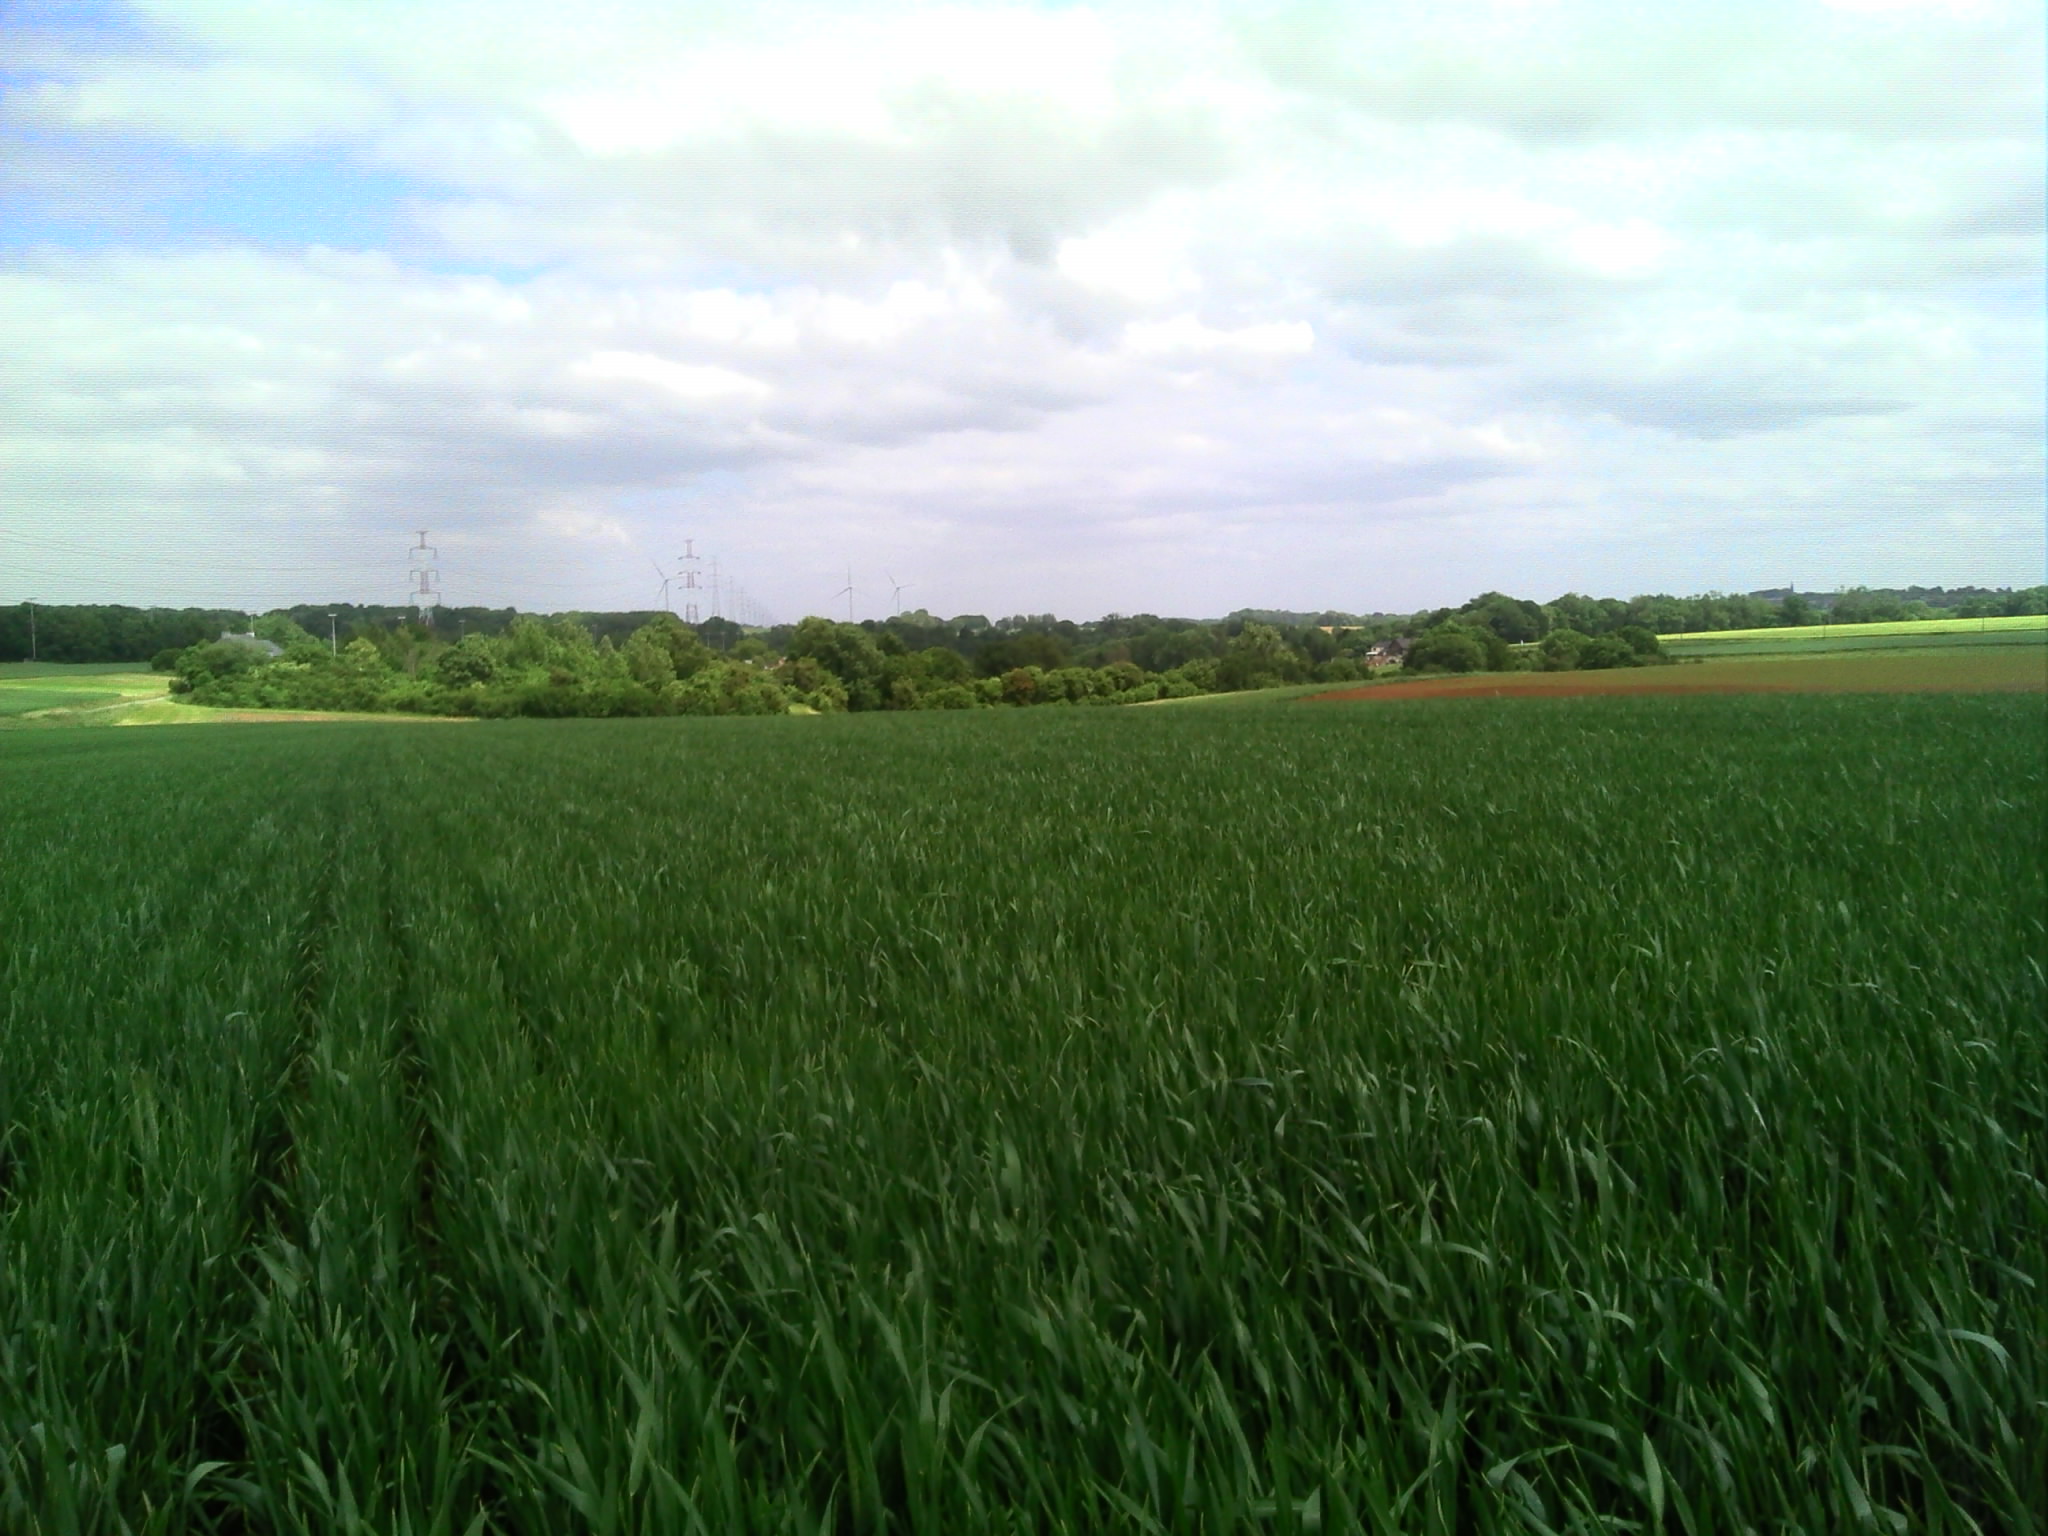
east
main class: Cropland
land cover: Common wheat
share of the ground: > 75 %
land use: Agriculture (excluding fallow land and kitchen gardens)
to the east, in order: Common wheat; Potatoes
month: June
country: BE
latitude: 50.4914
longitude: 4.6540
